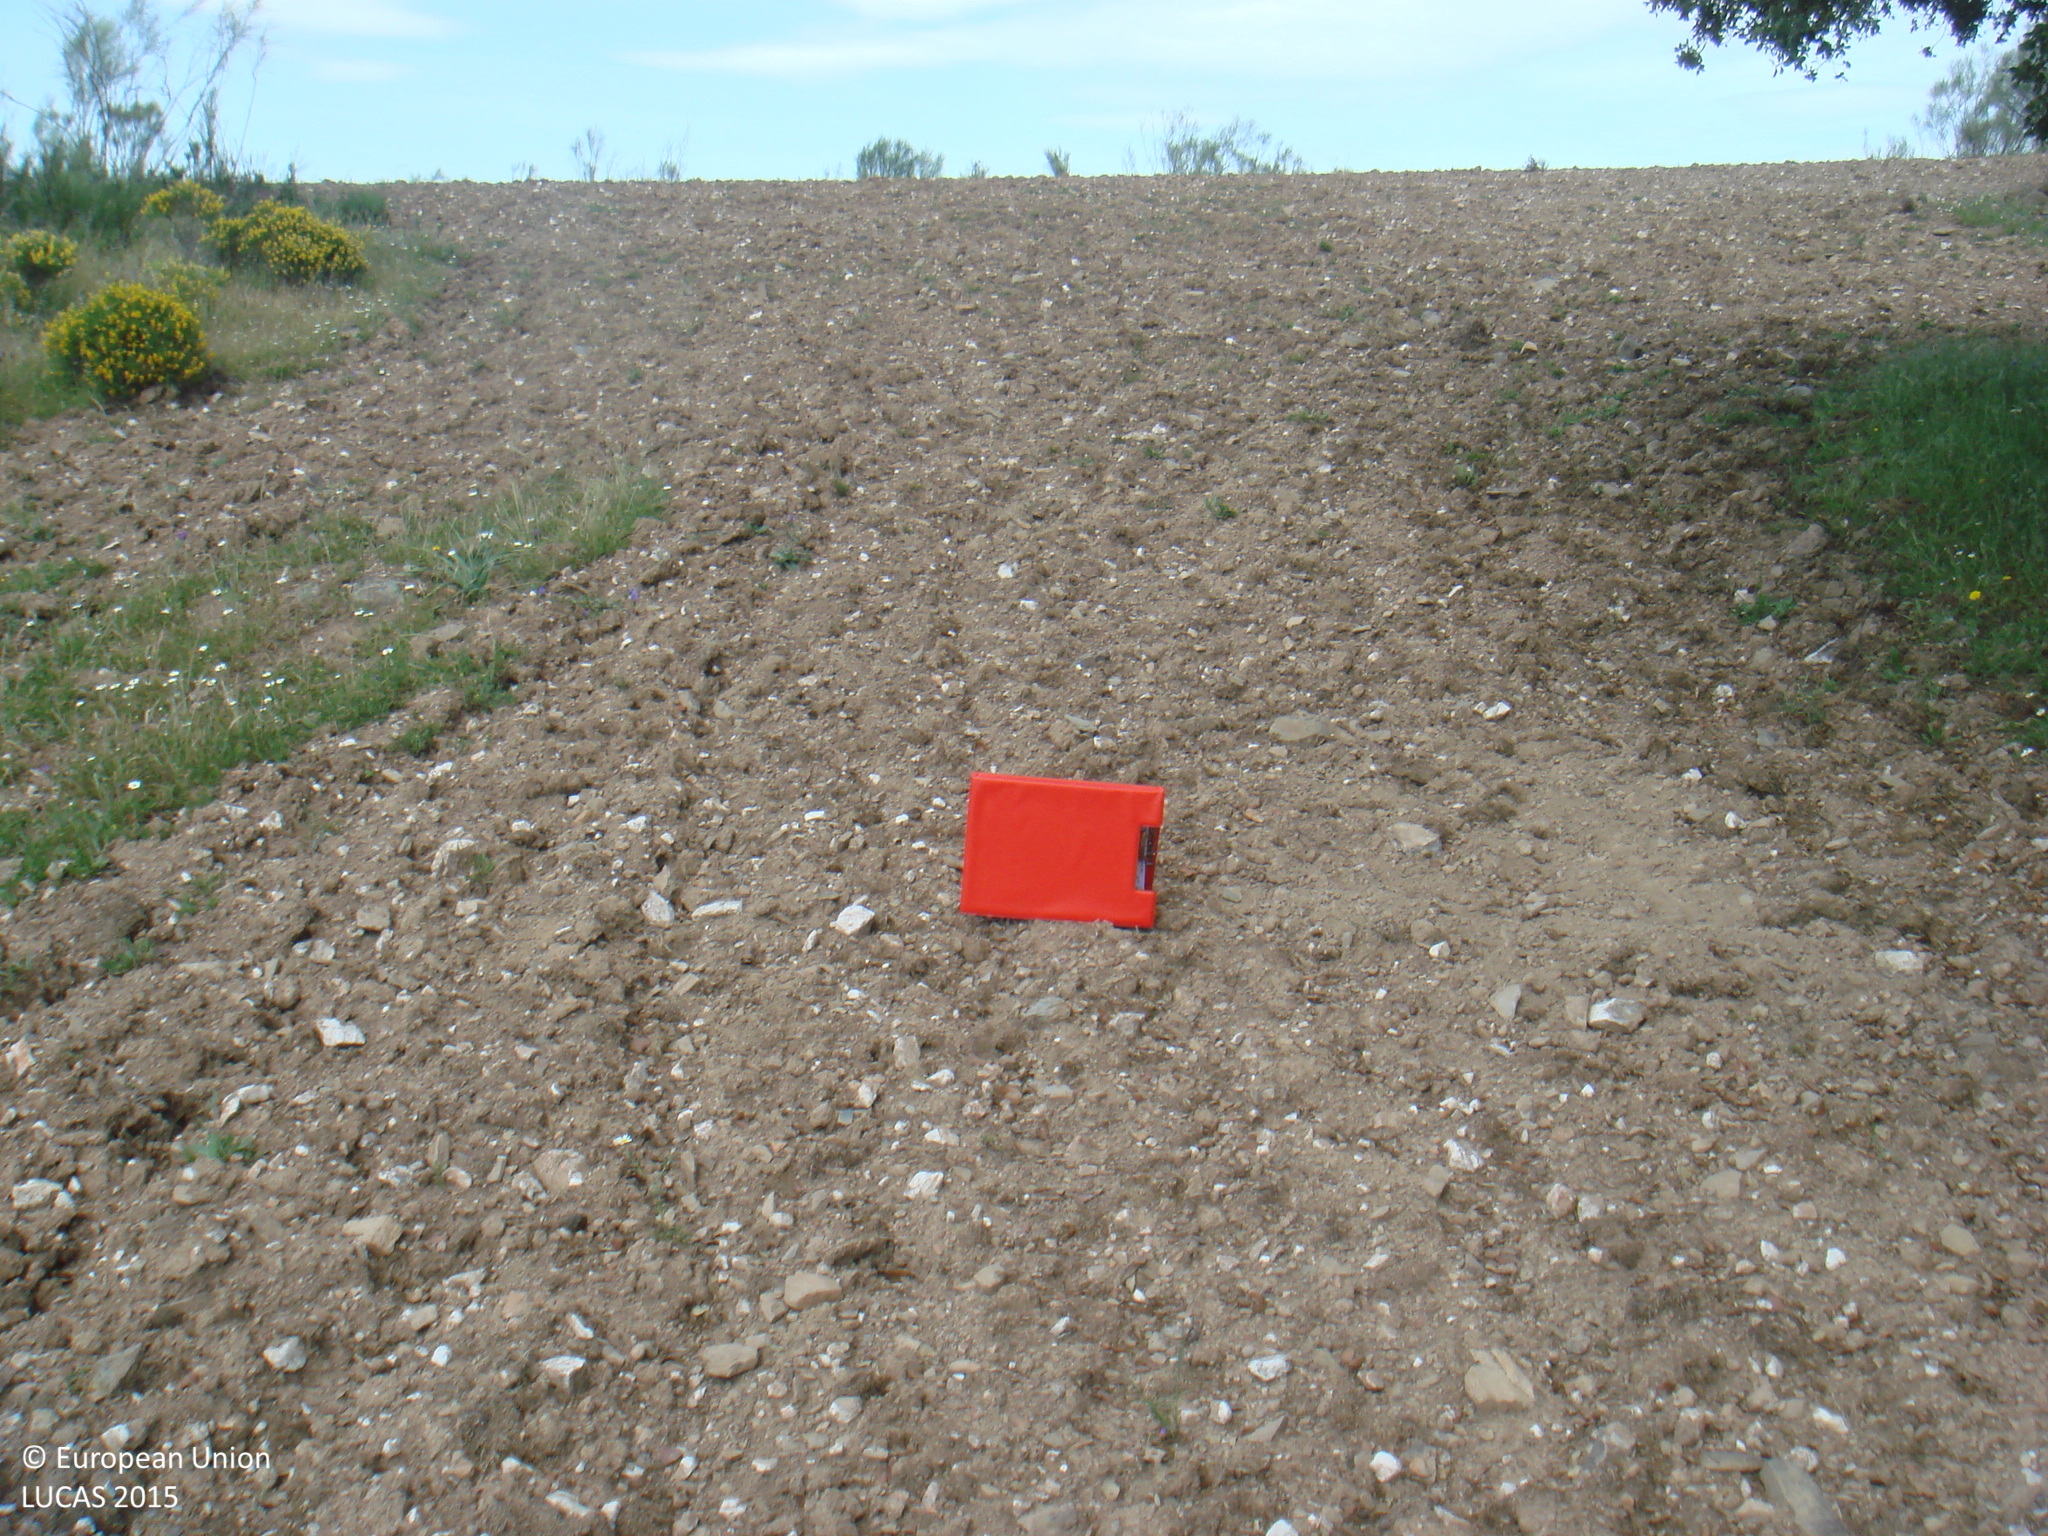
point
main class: Woodland
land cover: Broadleaved woodland
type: broadleaved evergreen forest
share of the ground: 25 - 50 %
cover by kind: unconsolidated bare surface 70 %, broadleaved forest trees 30 %
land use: Forestry
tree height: > 5 m
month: May
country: ES
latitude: 38.3846
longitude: -5.0347
